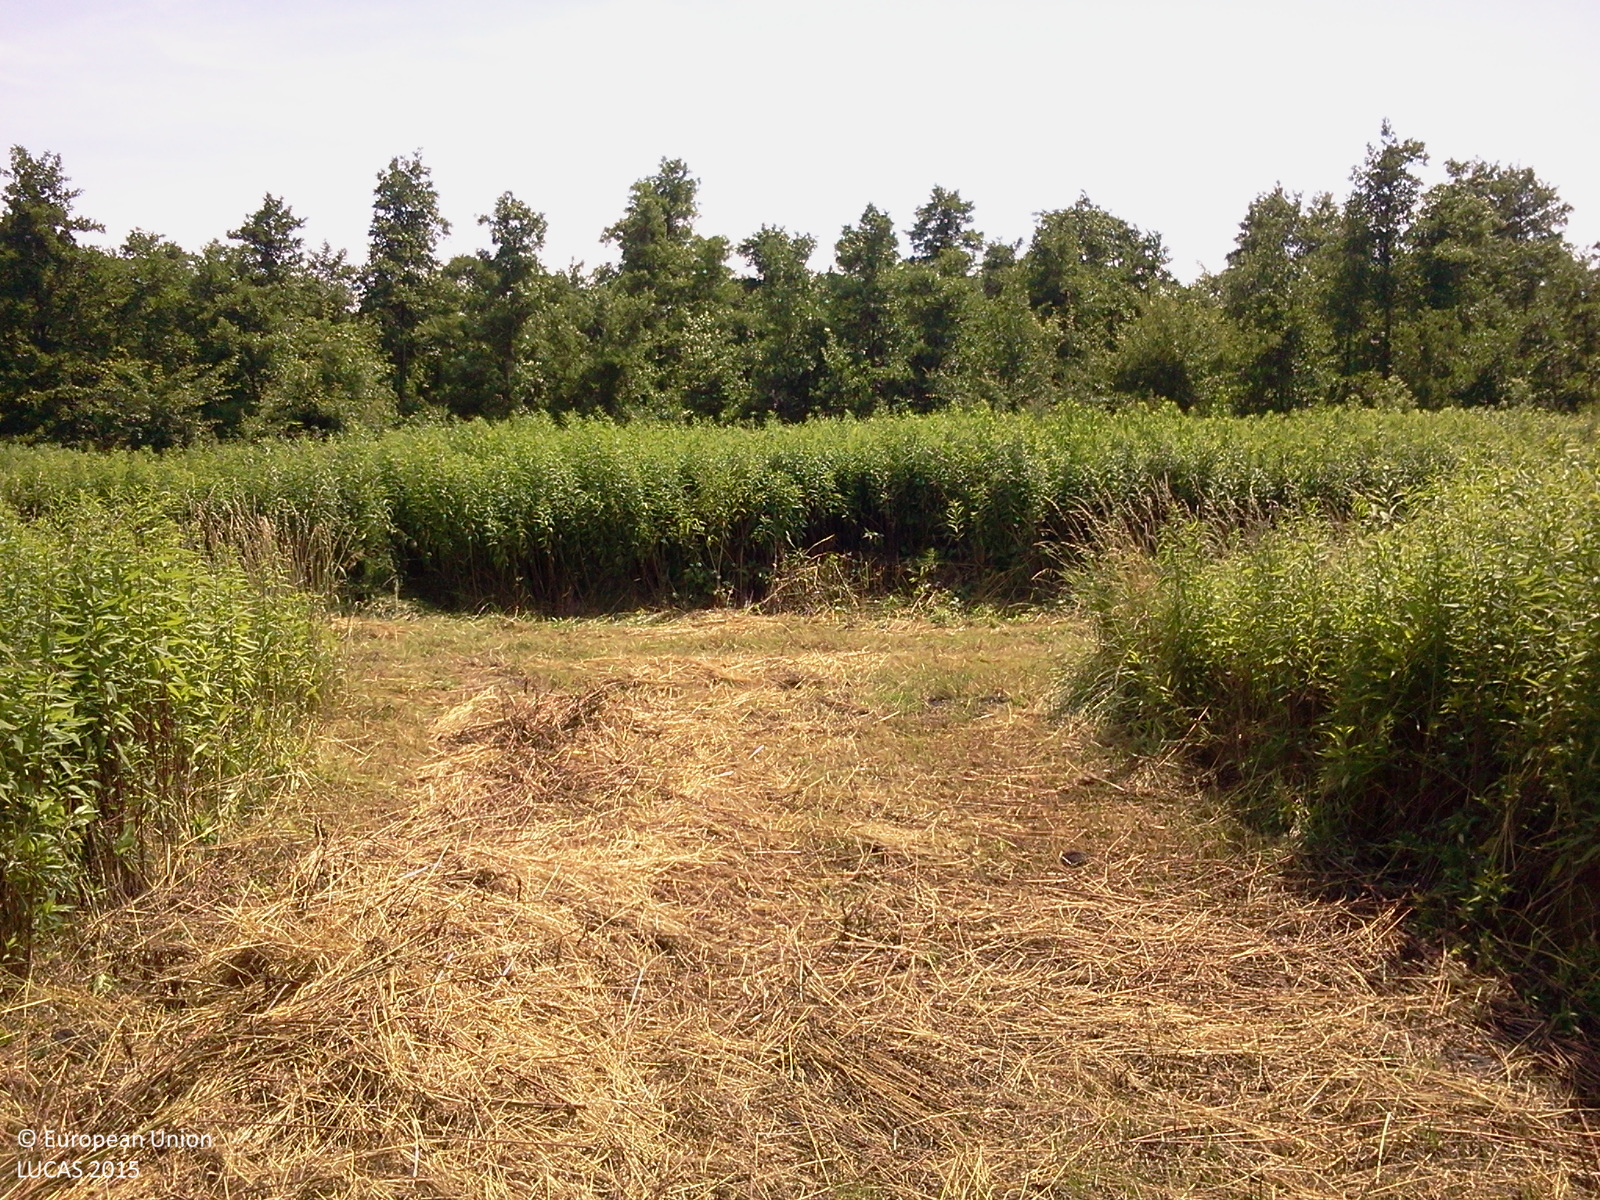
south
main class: Grassland
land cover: Grassland without tree/shrub cover
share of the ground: > 75 %
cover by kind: herbaceous plants 100 %
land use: Agriculture (excluding fallow land and kitchen gardens)
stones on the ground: < 10 %
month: June
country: HU
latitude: 46.7377
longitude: 16.9790
